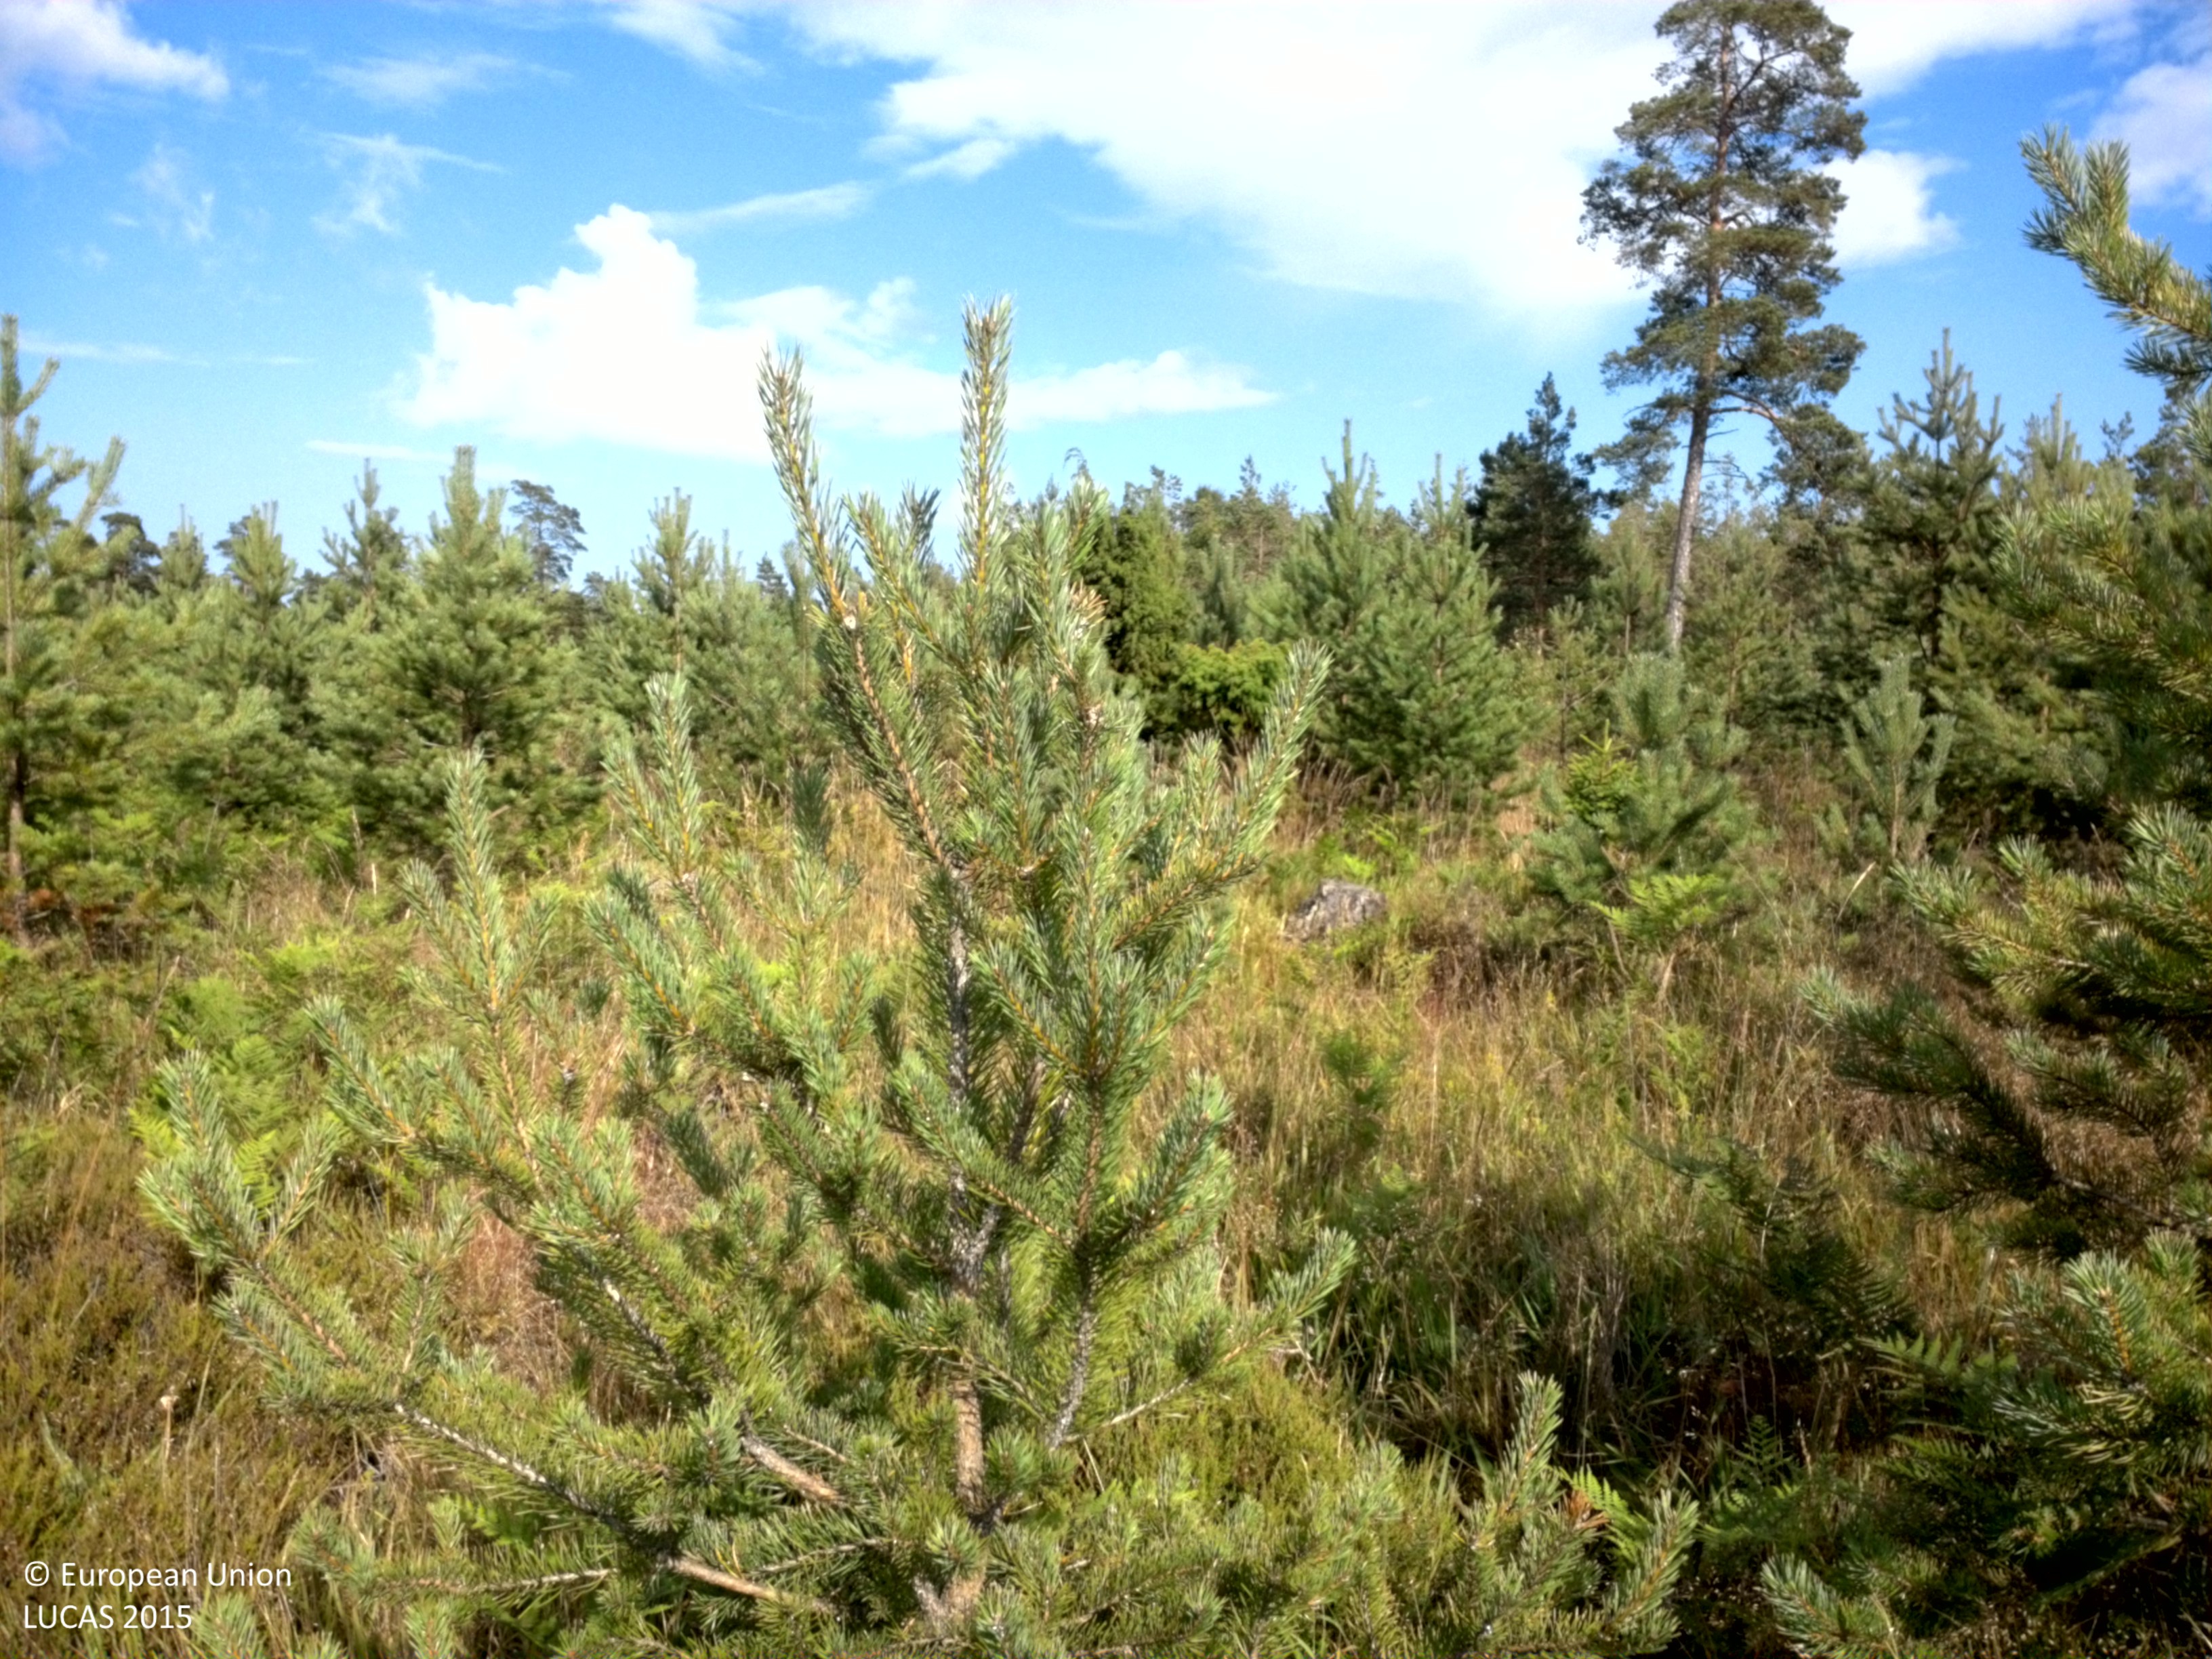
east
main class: Woodland
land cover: Pine dominated coniferous woodland
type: hemiboreal forest and nemoral coniferous forest and mixed broadleaved-coniferous forest
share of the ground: 50 - 75 %
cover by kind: coniferous forest trees 55 %, herbaceous plants 40 %, shrubs 5 %
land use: Forestry
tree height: < 5 m
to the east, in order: Pine dominated coniferous woodland; Grass margins; Paved roads, cycling and walking lanes; Grass margins; Pine dominated coniferous woodland
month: July
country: SE
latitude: 57.4710
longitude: 18.6301
